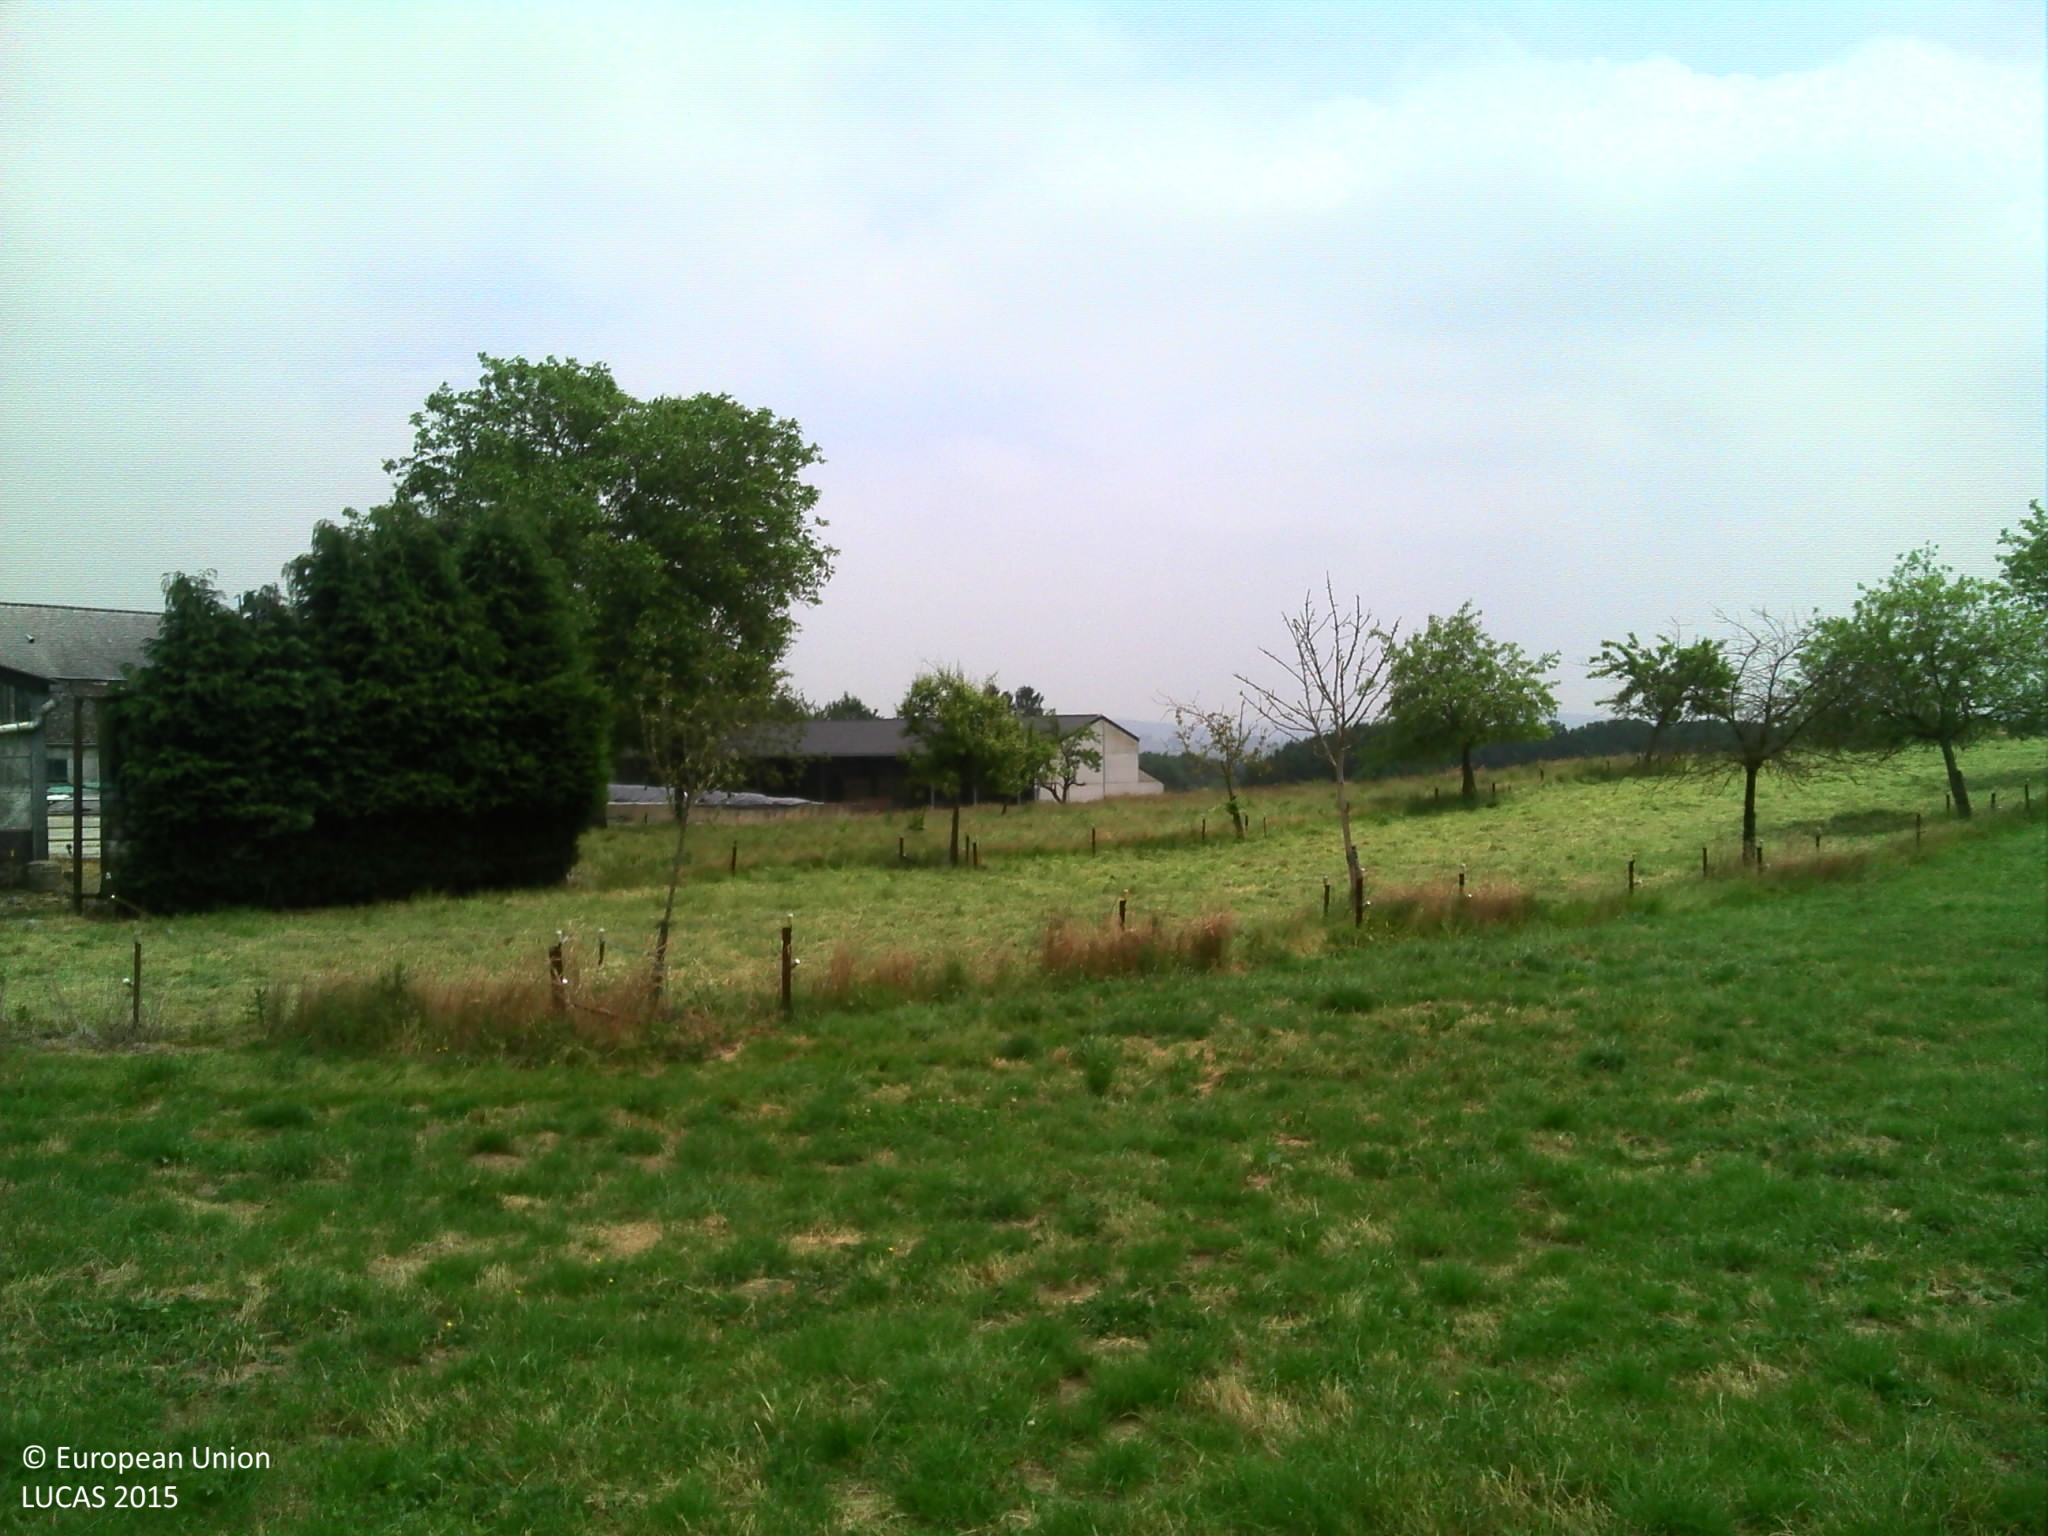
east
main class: Grassland
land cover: Grassland without tree/shrub cover
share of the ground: > 75 %
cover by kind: herbaceous plants 100 %
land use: Agriculture (excluding fallow land and kitchen gardens)
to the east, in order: Grassland without tree/shrub cover; Fences; Grassland without tree/shrub cover; Fences; Conifer hedges; Artificial constructions in urban areas; Grassland with sparse tree/shrub cover; Artificial constructions in urban areas; Grass margins; Paved roads, cycling and walking lanes; Grass margins; Fences; Grassland without tree/shrub cover
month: June
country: BE
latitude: 50.3841
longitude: 5.5119
